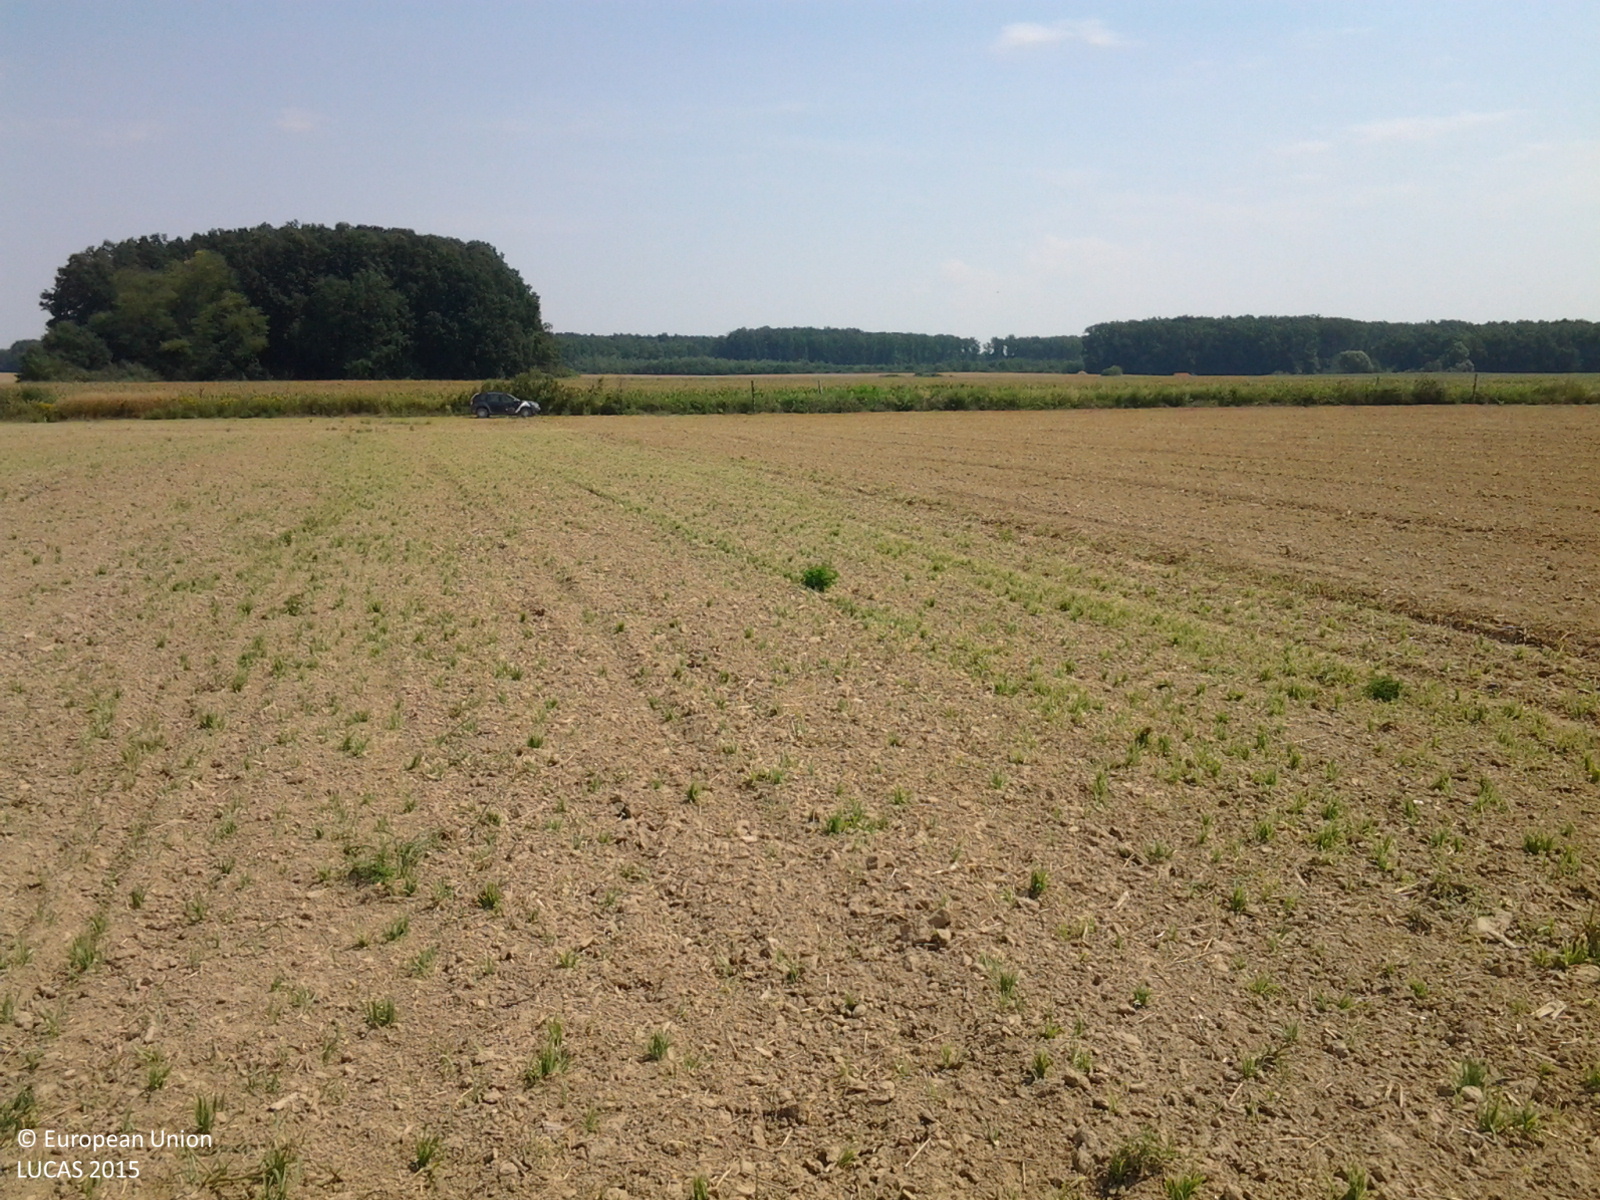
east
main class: Cropland
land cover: Common wheat
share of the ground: < 10 %
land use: Agriculture (excluding fallow land and kitchen gardens)
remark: Harvested field
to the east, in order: Common wheat; Tracks; Fences; Shruby margins; Ditches and canals; Grass margins; Paved roads, cycling and walking lanes; Grass margins; Ditches and canals; Grass margins; Maize
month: August
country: HU
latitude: 46.1384
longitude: 17.2908
